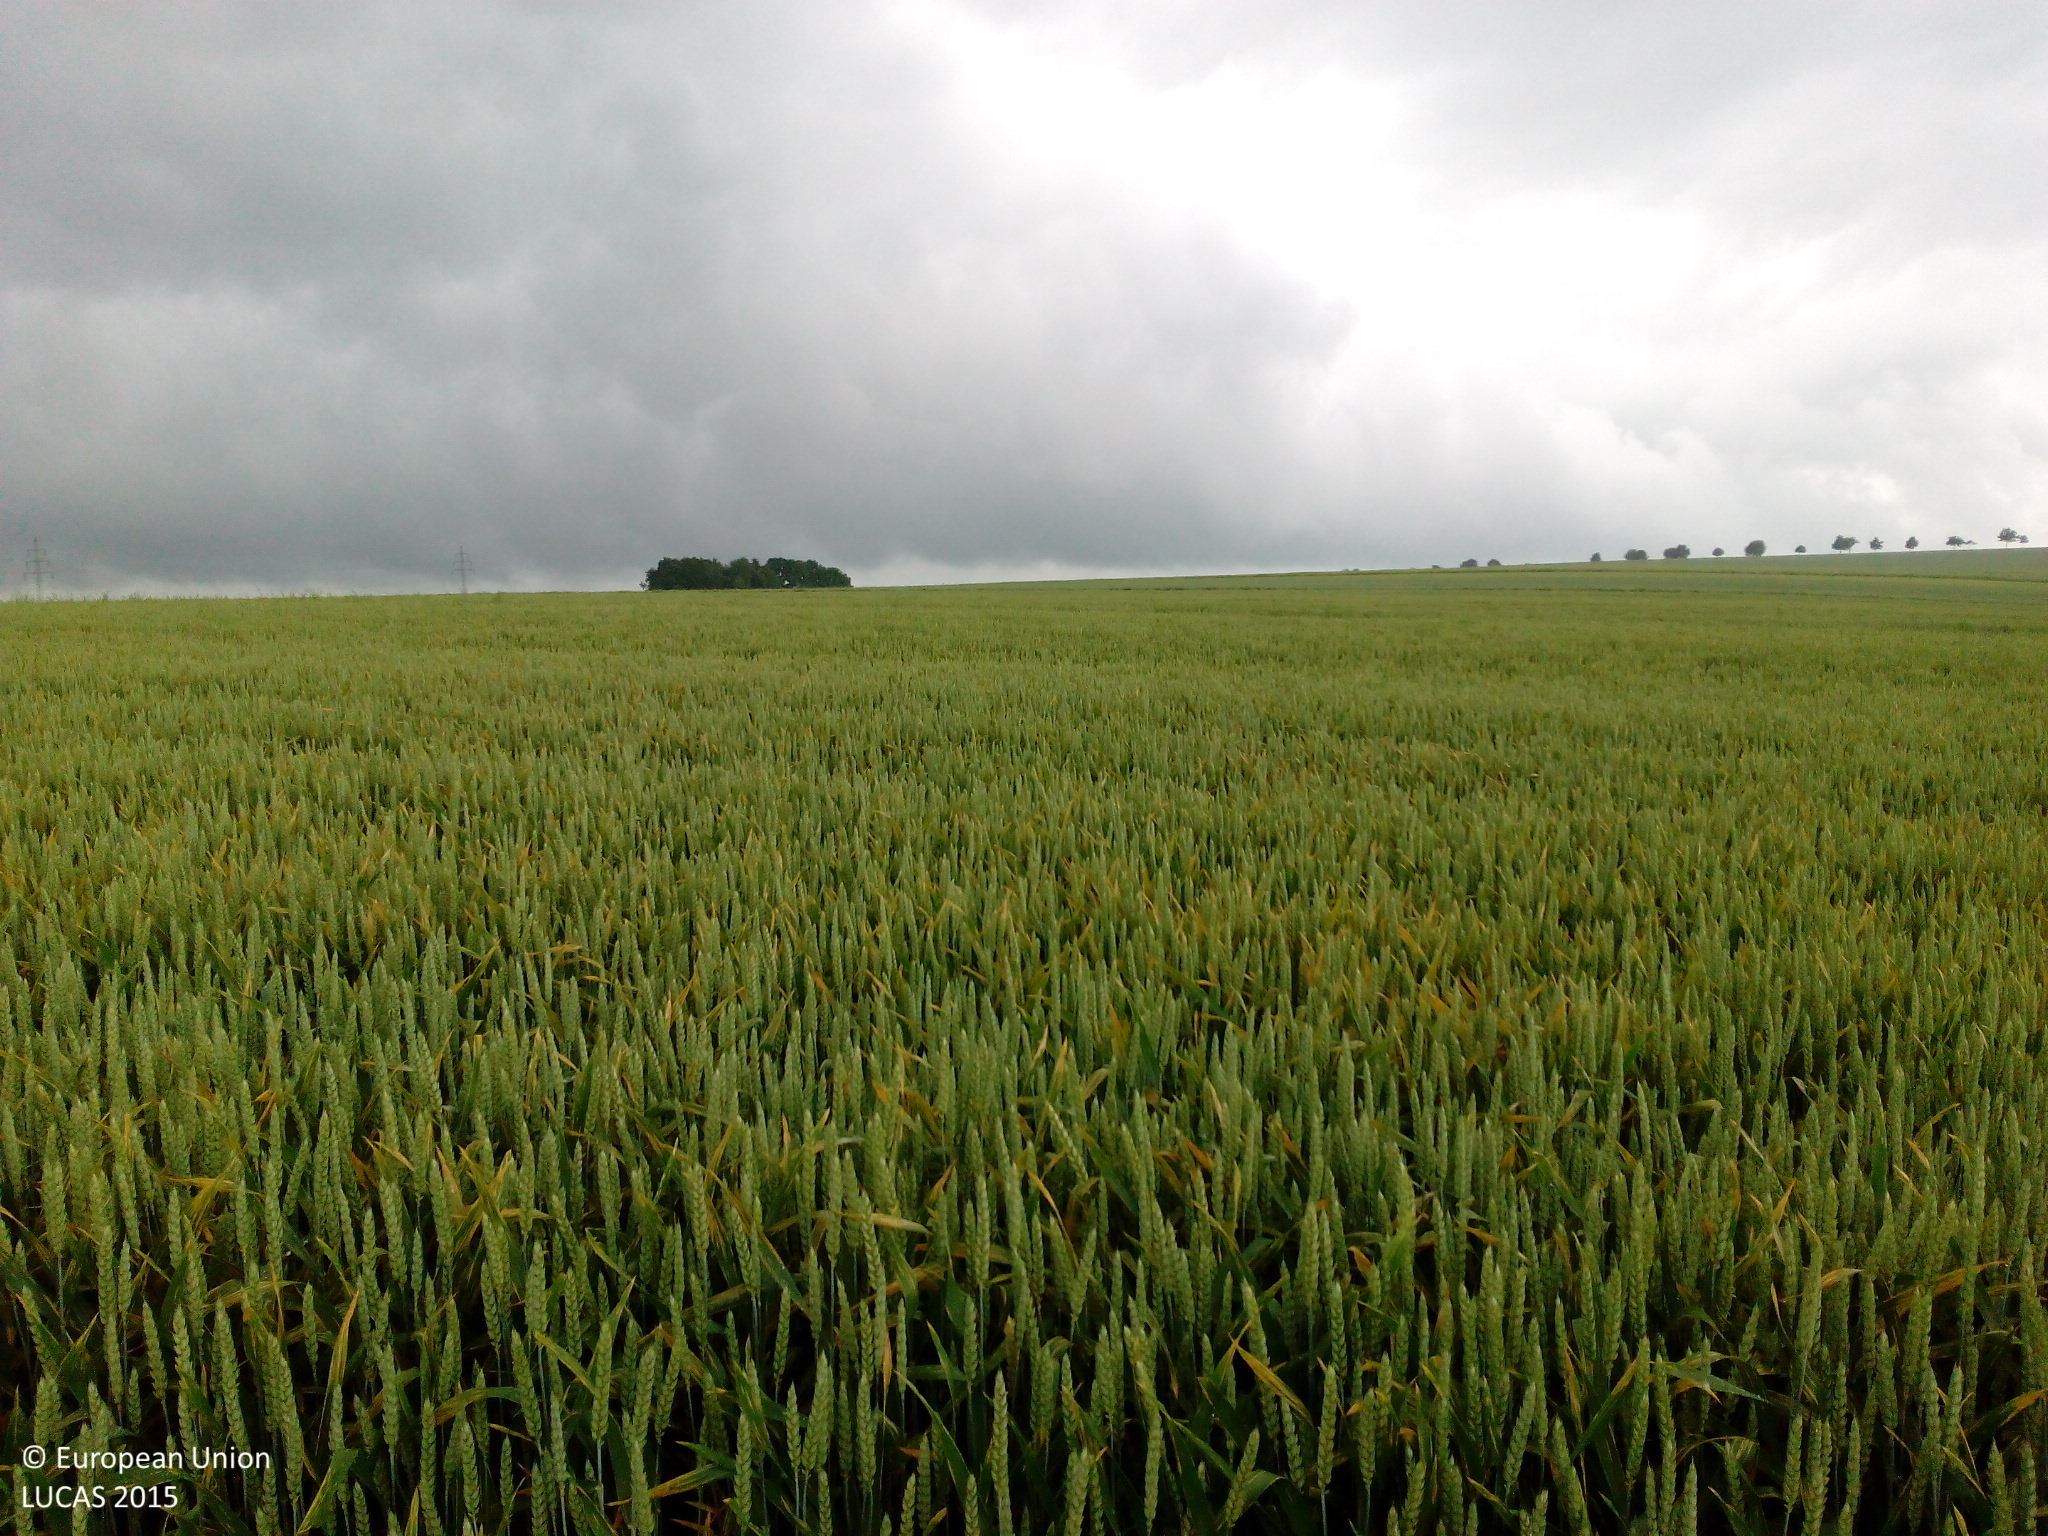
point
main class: Cropland
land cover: Common wheat
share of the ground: > 75 %
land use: Agriculture (excluding fallow land and kitchen gardens)
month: June
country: DE
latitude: 51.0060
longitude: 13.0927
